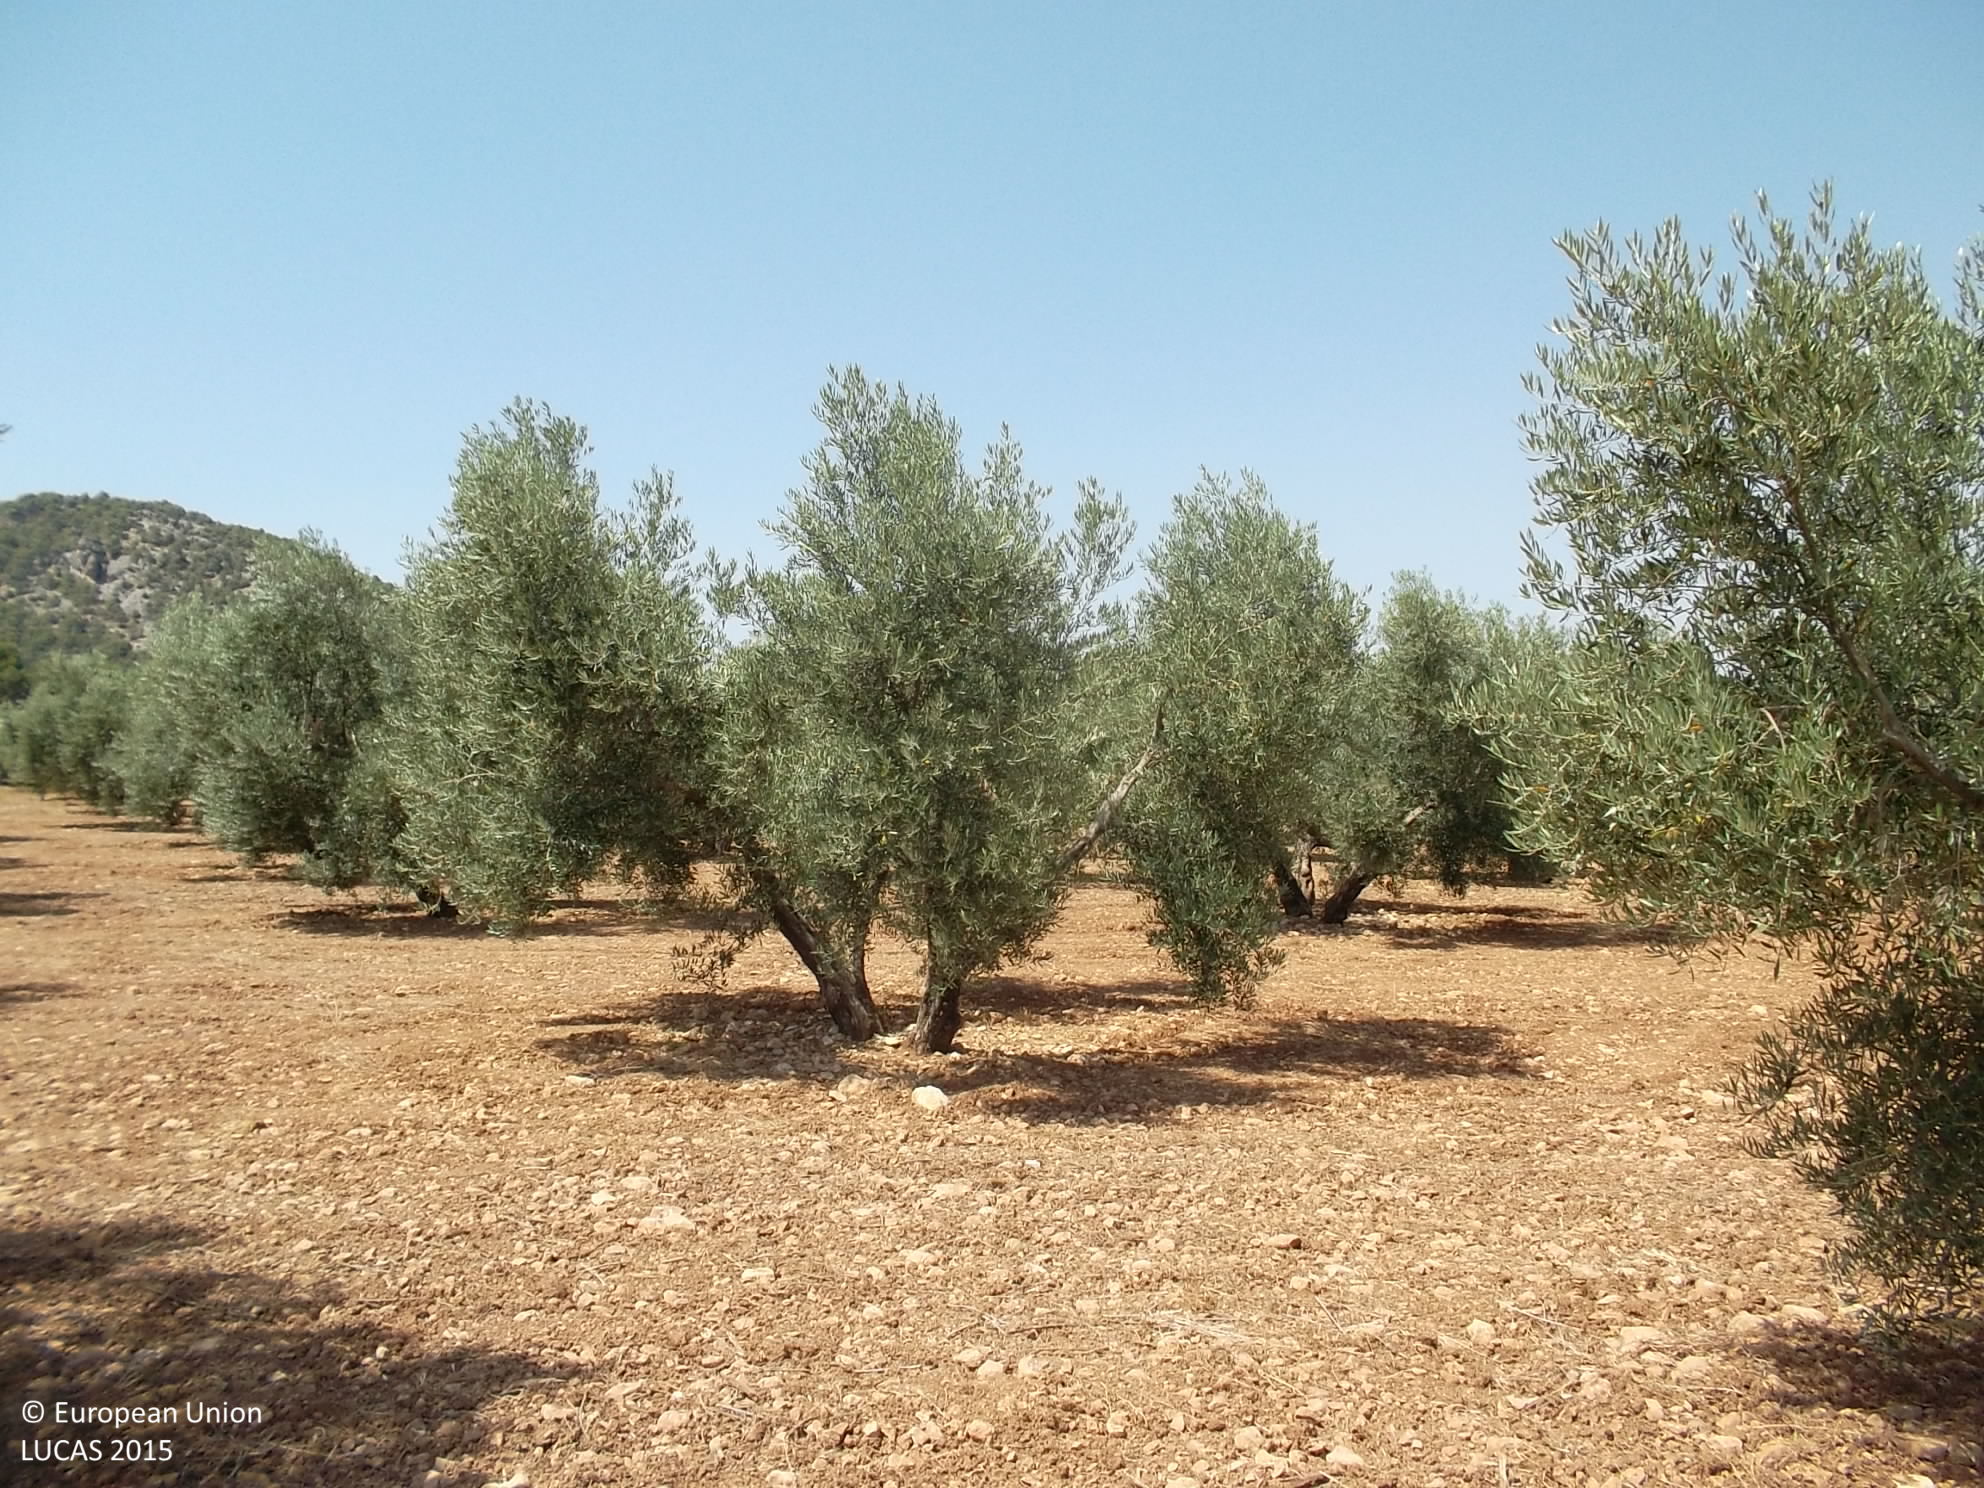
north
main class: Cropland
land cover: Olive groves
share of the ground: 25 - 50 %
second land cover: Other bare soil
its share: > 75 %
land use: Agriculture (excluding fallow land and kitchen gardens)
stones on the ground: 10 - 25 %
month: June
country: ES
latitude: 37.7606
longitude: -2.9211
